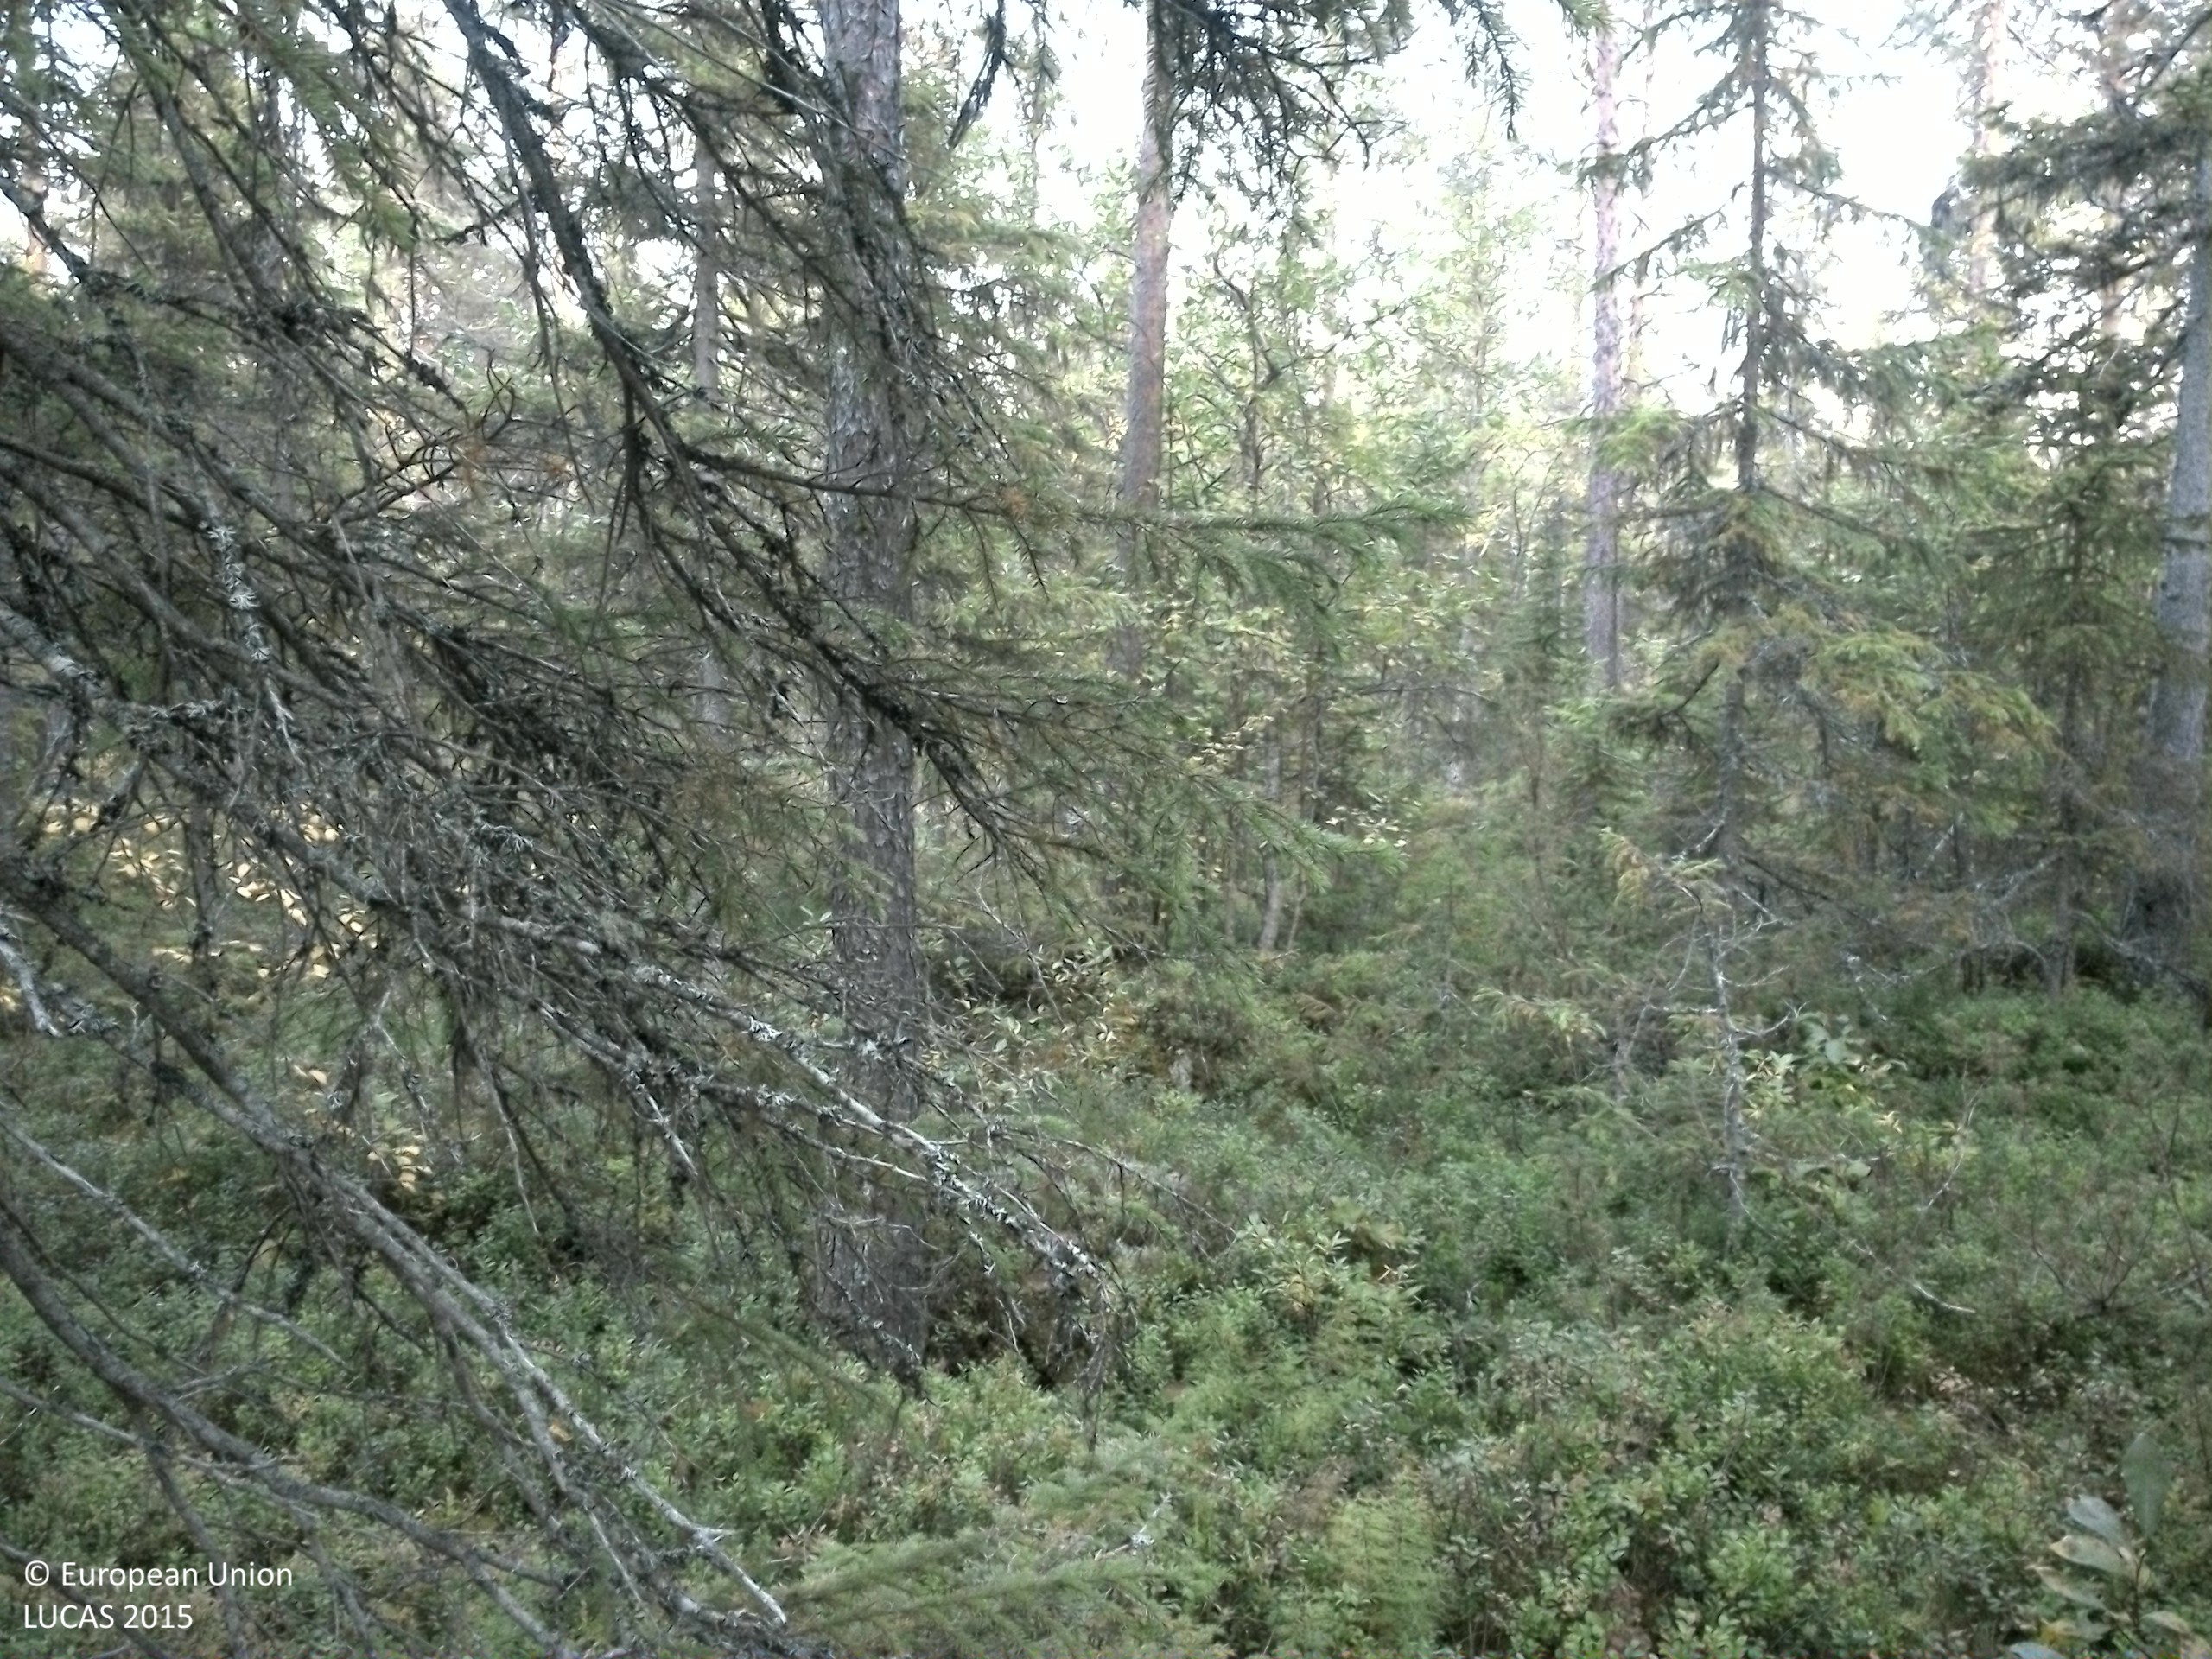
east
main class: Woodland
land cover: Other mixed woodland
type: boreal forest
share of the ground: 50 - 75 %
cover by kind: coniferous forest trees 45 %, shrubs 30 %, broadleaved forest trees 15 %, lichens and mosses 10 %
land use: Forestry
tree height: > 5 m
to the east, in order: Other mixed woodland; Pine dominated coniferous woodland; Shrubland without tree cover; Rocks and stones; Shrubland without tree cover
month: September
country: SE
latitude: 63.8953
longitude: 16.6730
